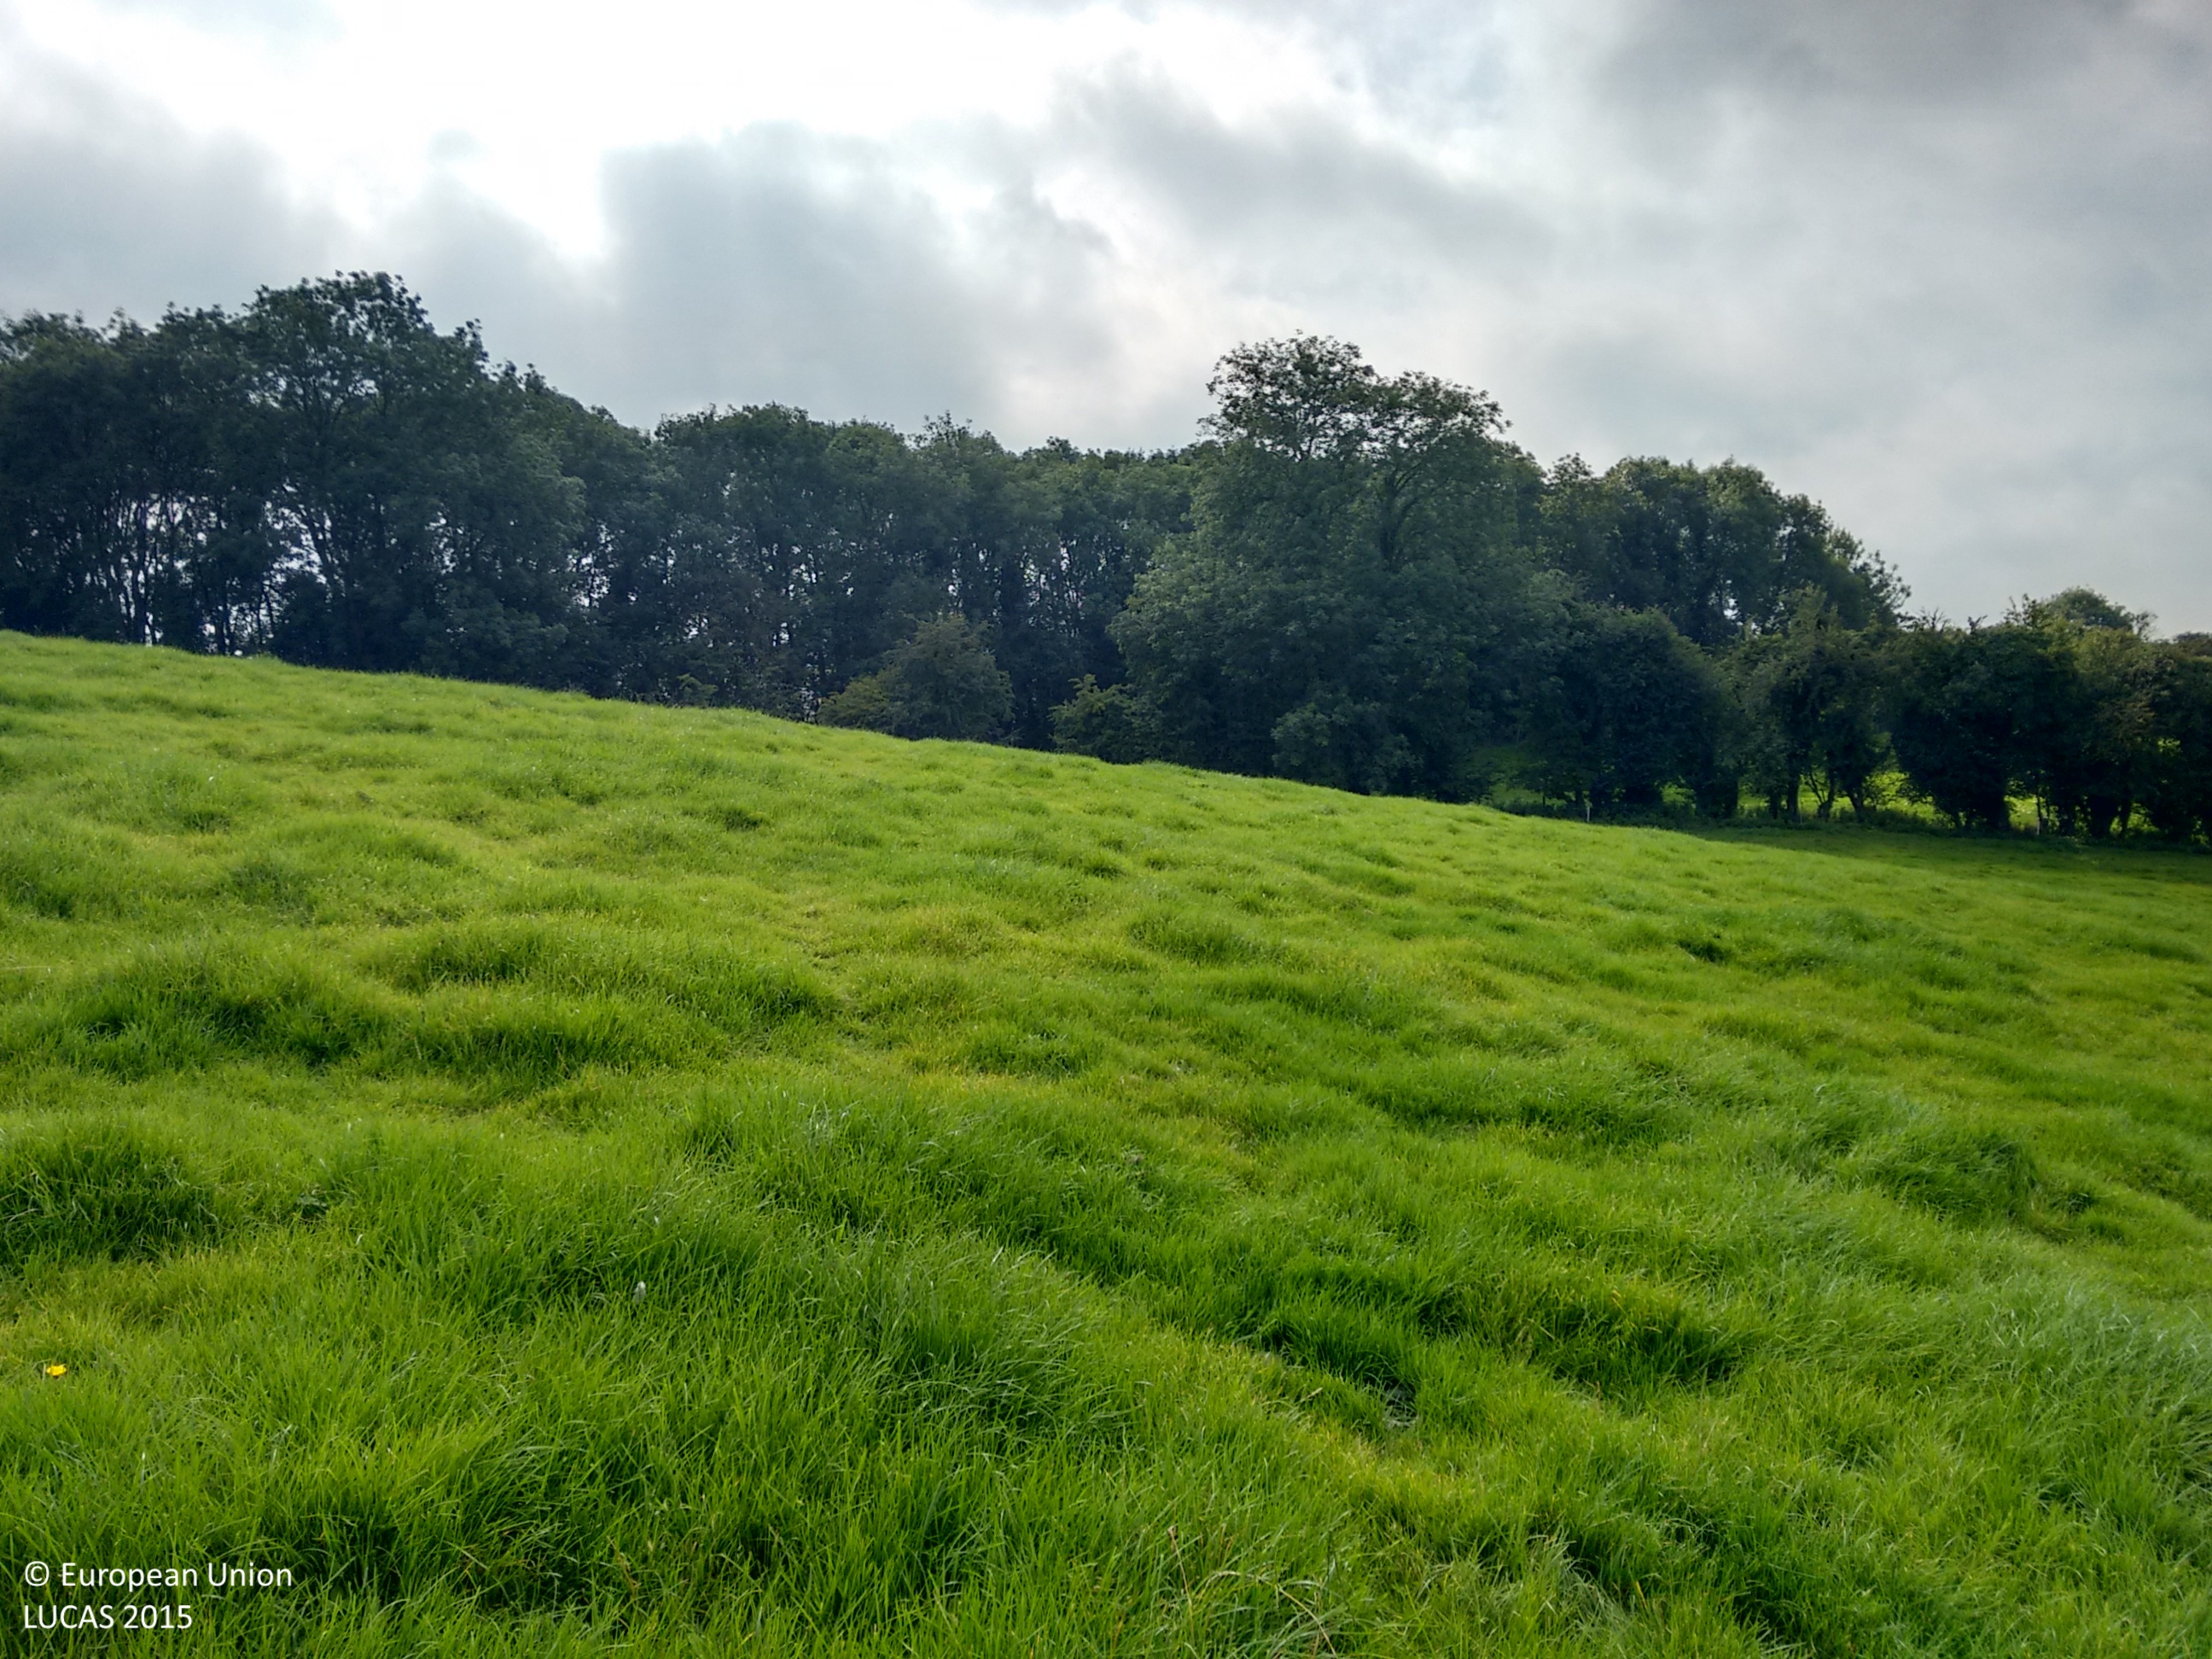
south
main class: Grassland
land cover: Grassland without tree/shrub cover
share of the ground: > 75 %
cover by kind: herbaceous plants 100 %
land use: Agriculture (excluding fallow land and kitchen gardens)
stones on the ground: < 10 %
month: September
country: IE
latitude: 54.2390
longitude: -7.0665
